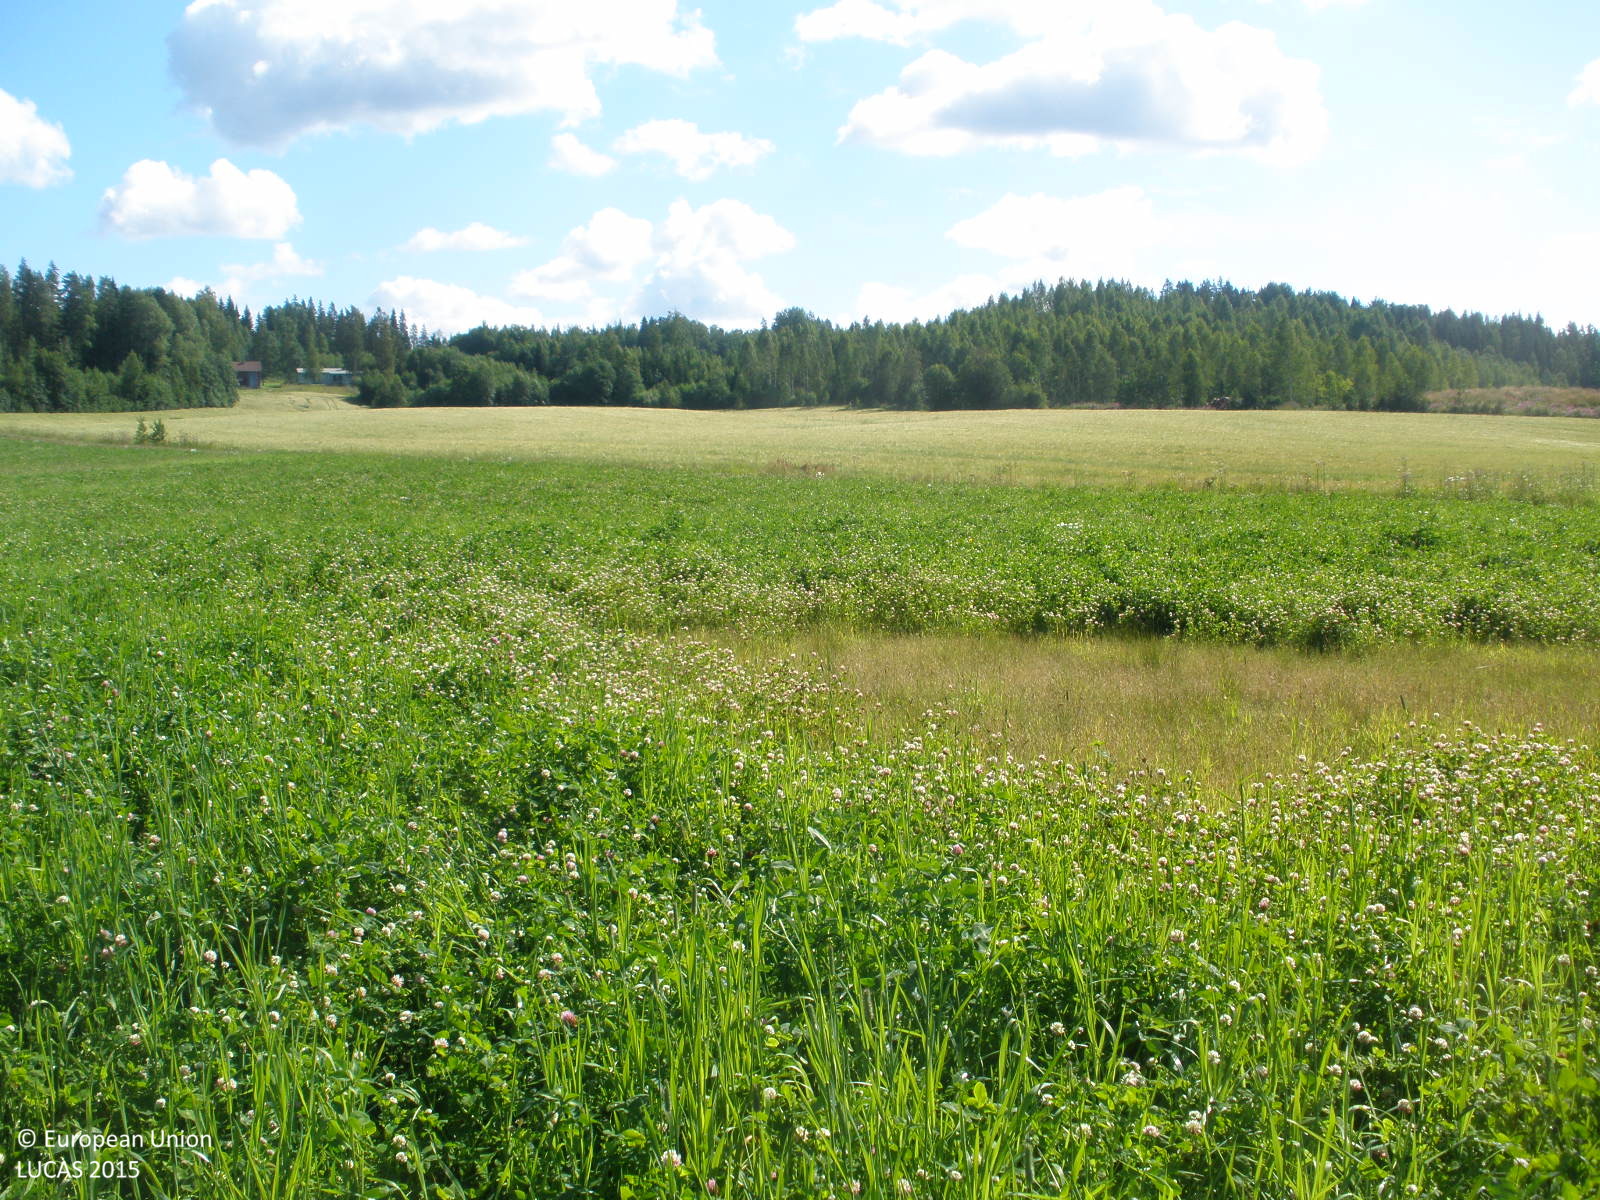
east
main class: Cropland
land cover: Other leguminous and mixtures for fodder
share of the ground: > 75 %
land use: Agriculture (excluding fallow land and kitchen gardens)
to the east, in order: Other leguminous and mixtures for fodder; Grass margins; Ditches and canals; Grass margins; Barley
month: August
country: FI
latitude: 60.9551
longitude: 24.9775
